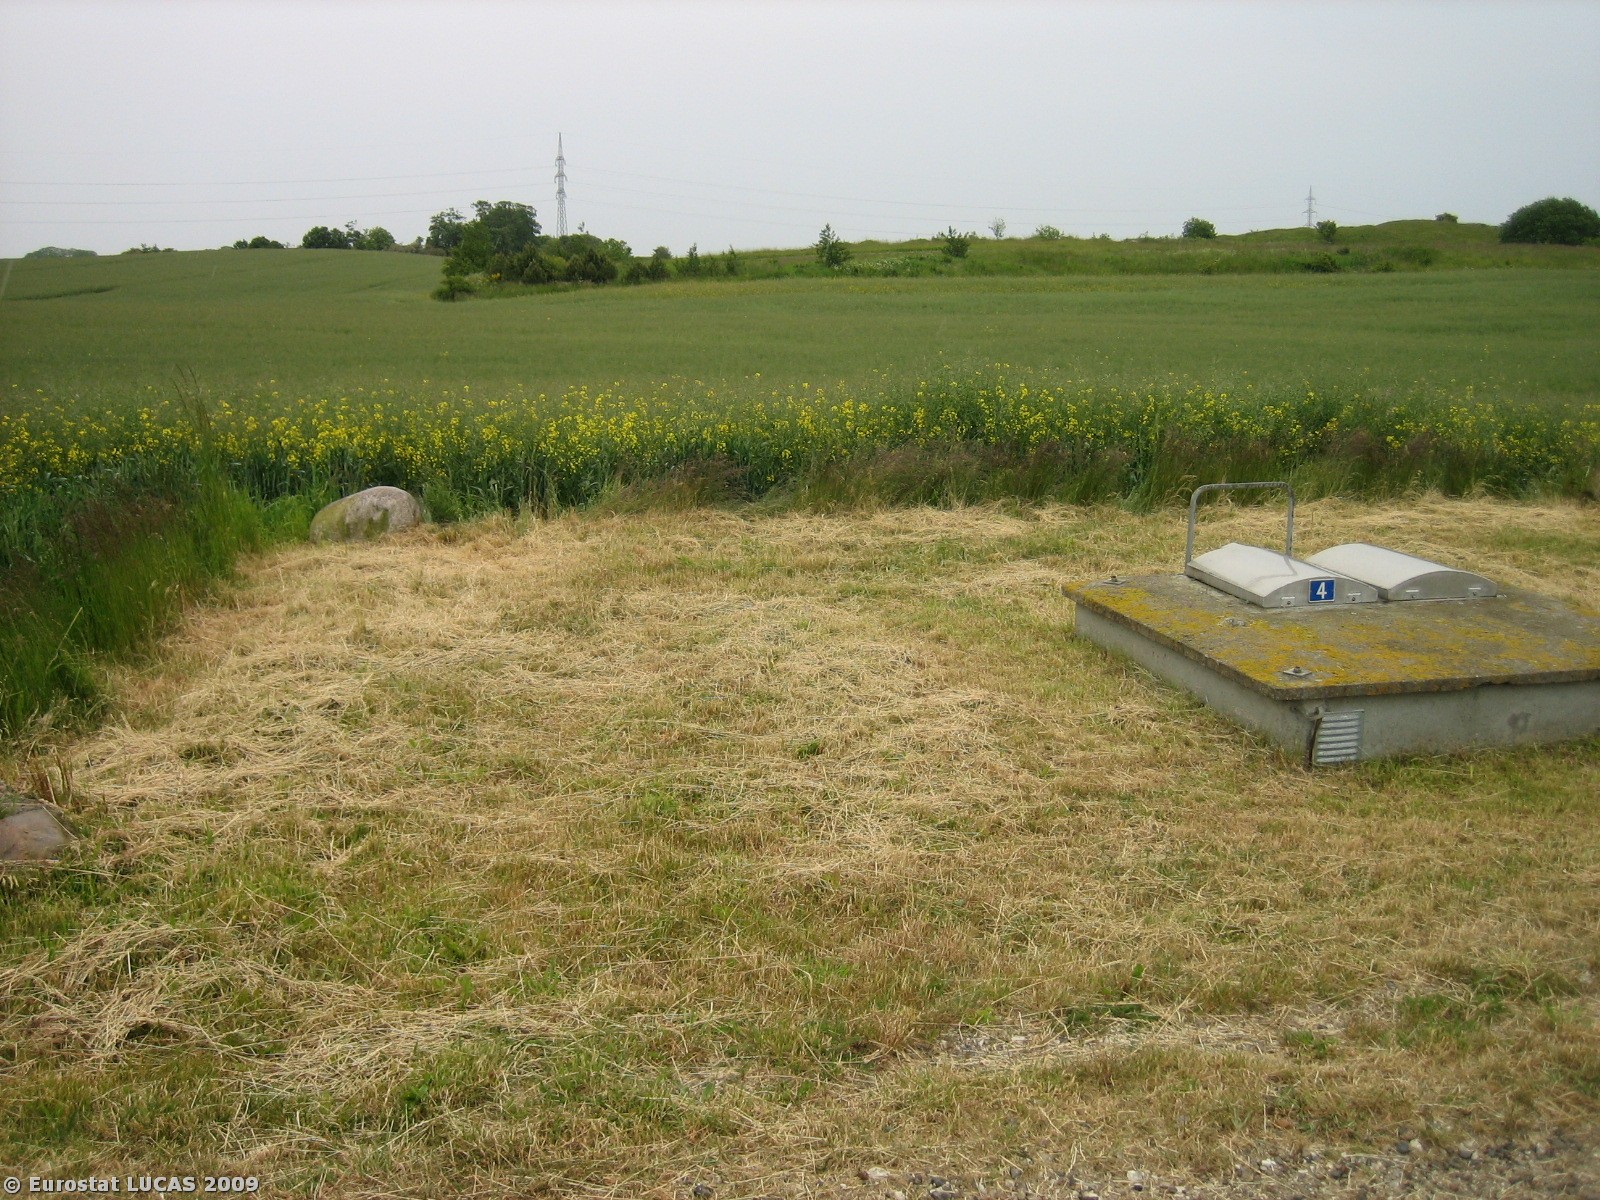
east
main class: Cropland
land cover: Common wheat
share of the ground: > 75 %
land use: Agriculture (excluding fallow land and kitchen gardens)
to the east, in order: Common wheat; Grass margins; Tracks; Grass margins; Rape and turnip rape
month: June
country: DK
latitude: 56.2415
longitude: 10.1773
